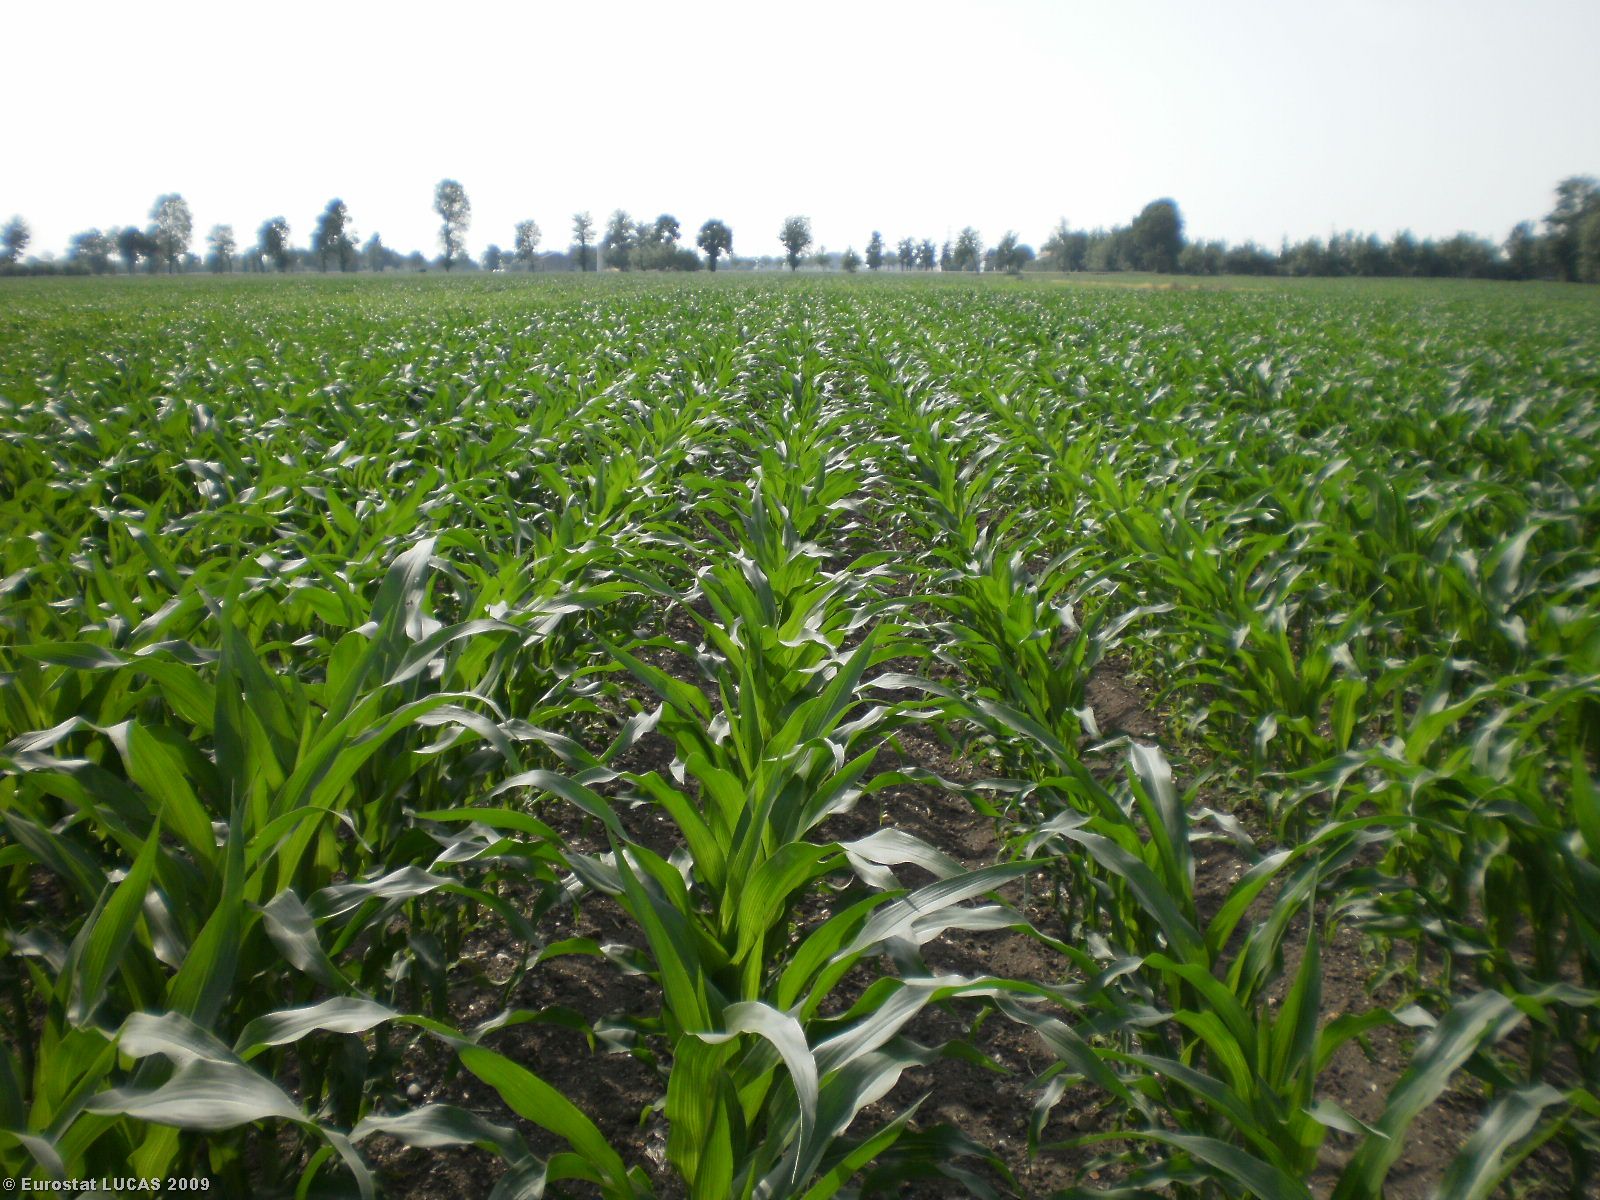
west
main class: Cropland
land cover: Maize
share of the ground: > 75 %
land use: Agriculture (excluding fallow land and kitchen gardens)
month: May
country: IT
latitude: 45.1771
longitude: 10.7748
